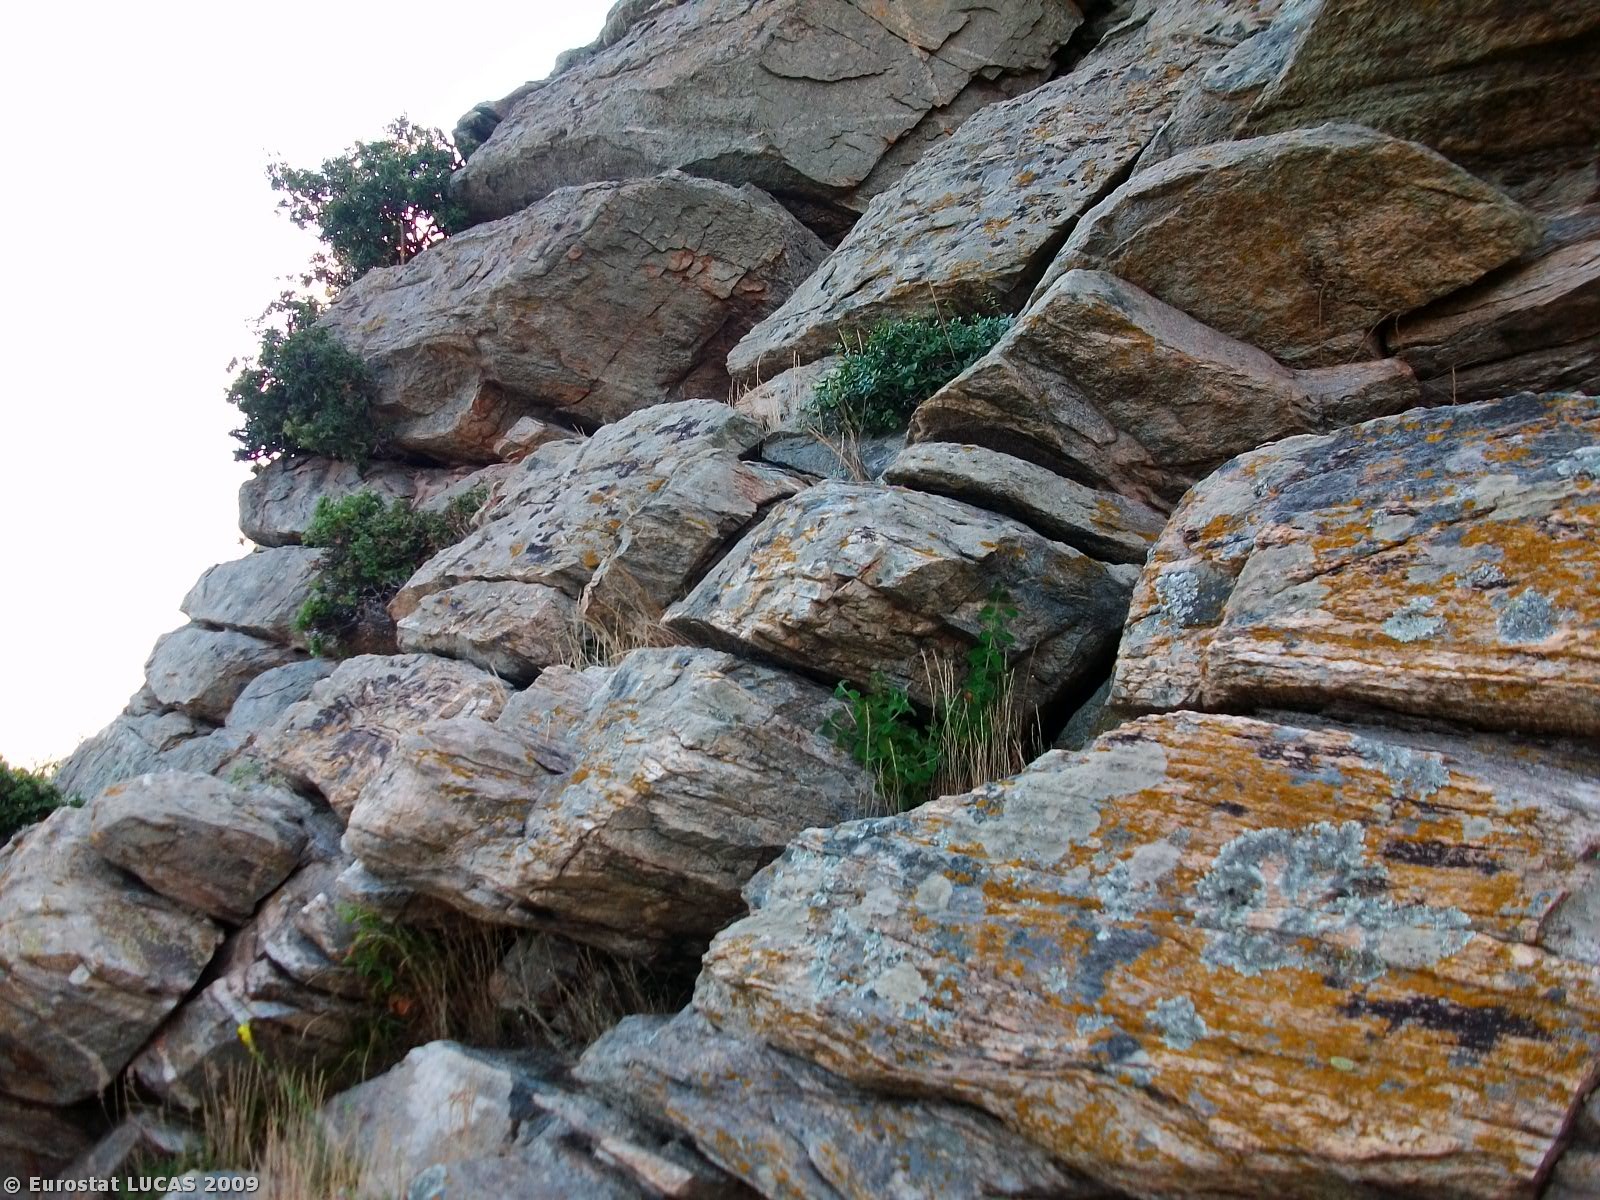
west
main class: Shrubland
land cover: Shrubland without tree cover
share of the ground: 50 - 75 %
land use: Agriculture (excluding fallow land and kitchen gardens)
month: June
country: GR
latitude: 40.8495
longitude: 24.2734
